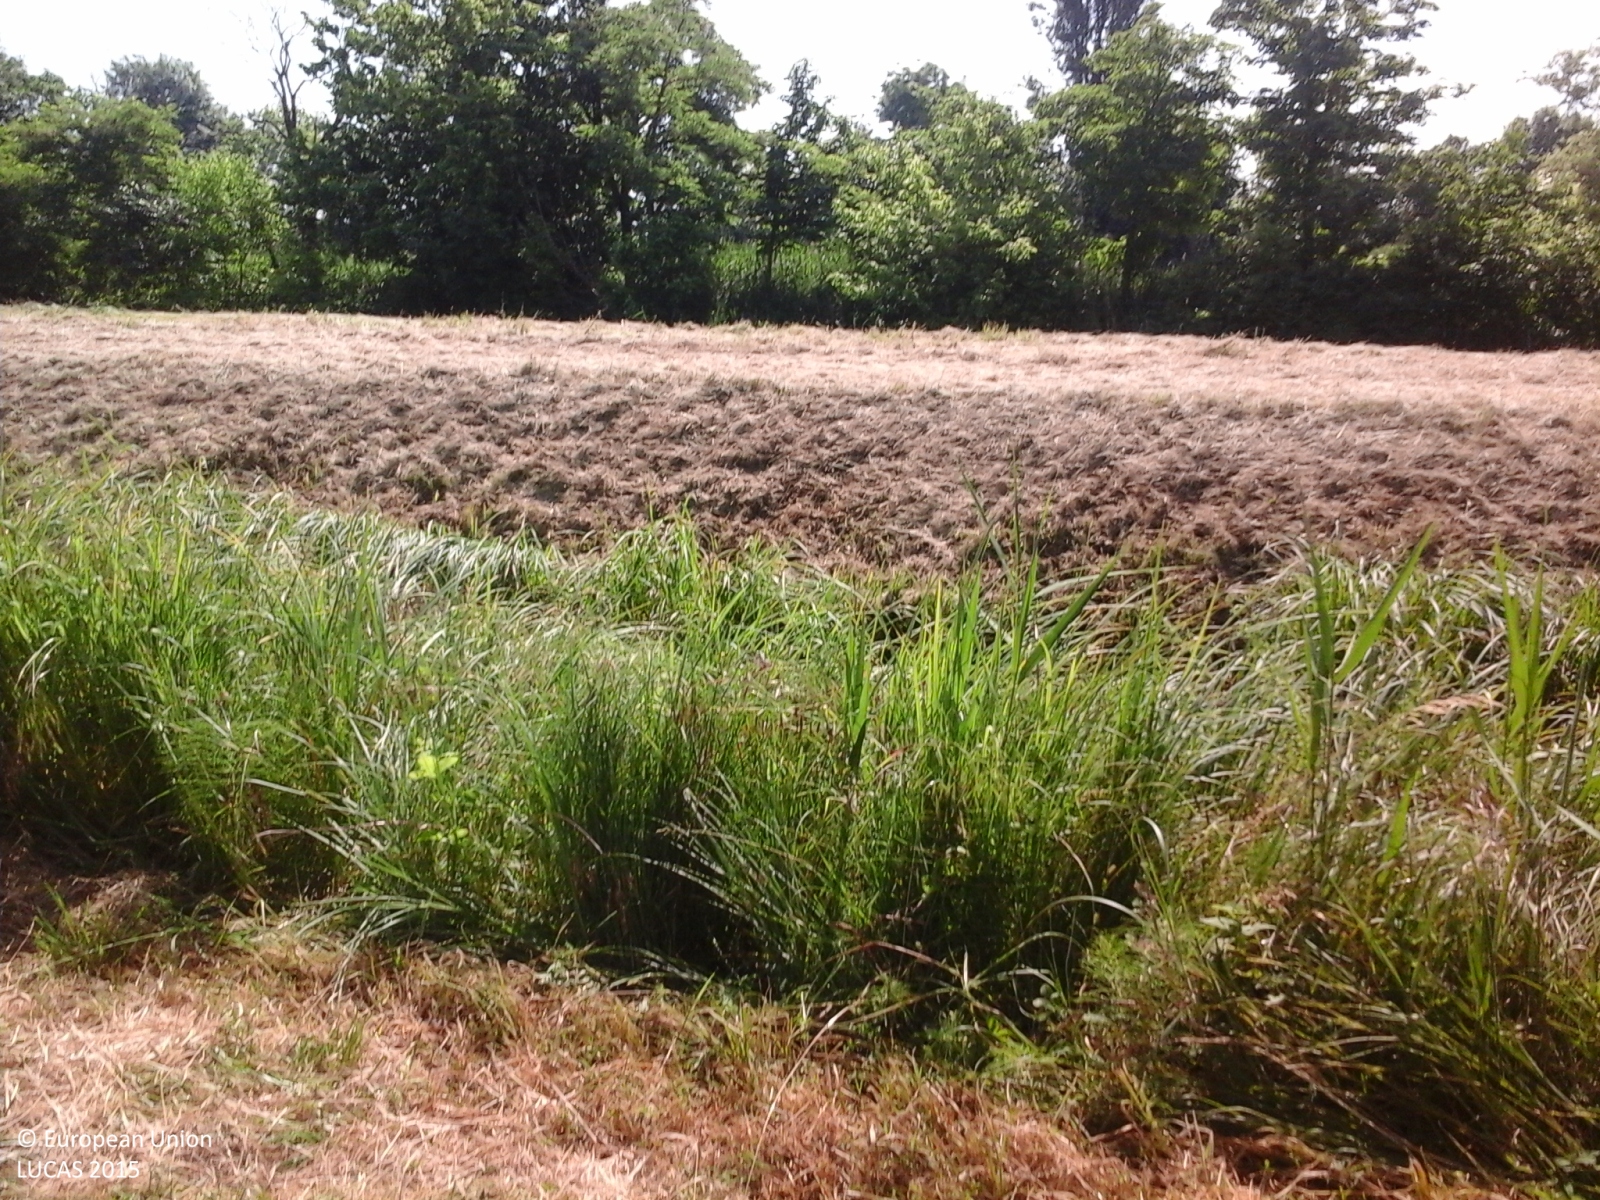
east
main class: Woodland
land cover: Broadleaved woodland
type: thermophilous deciduous forest
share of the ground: > 75 %
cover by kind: broadleaved forest trees 85 %, herbaceous plants 10 %, shrubs 5 %
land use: Other primary production
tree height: < 5 m
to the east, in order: Broadleaved woodland; Grassland without tree/shrub cover; Inland fresh running water; Grassland without tree/shrub cover; Ditches and canals; Paved roads, cycling and walking lanes; Grass margins; Fences; Lines of trees; Inland fresh water bodies; Lines of trees; Fences; Ditches and canals; Grassland without tree/shrub cover; Common wheat
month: May
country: IT
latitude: 44.7407
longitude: 11.1721
